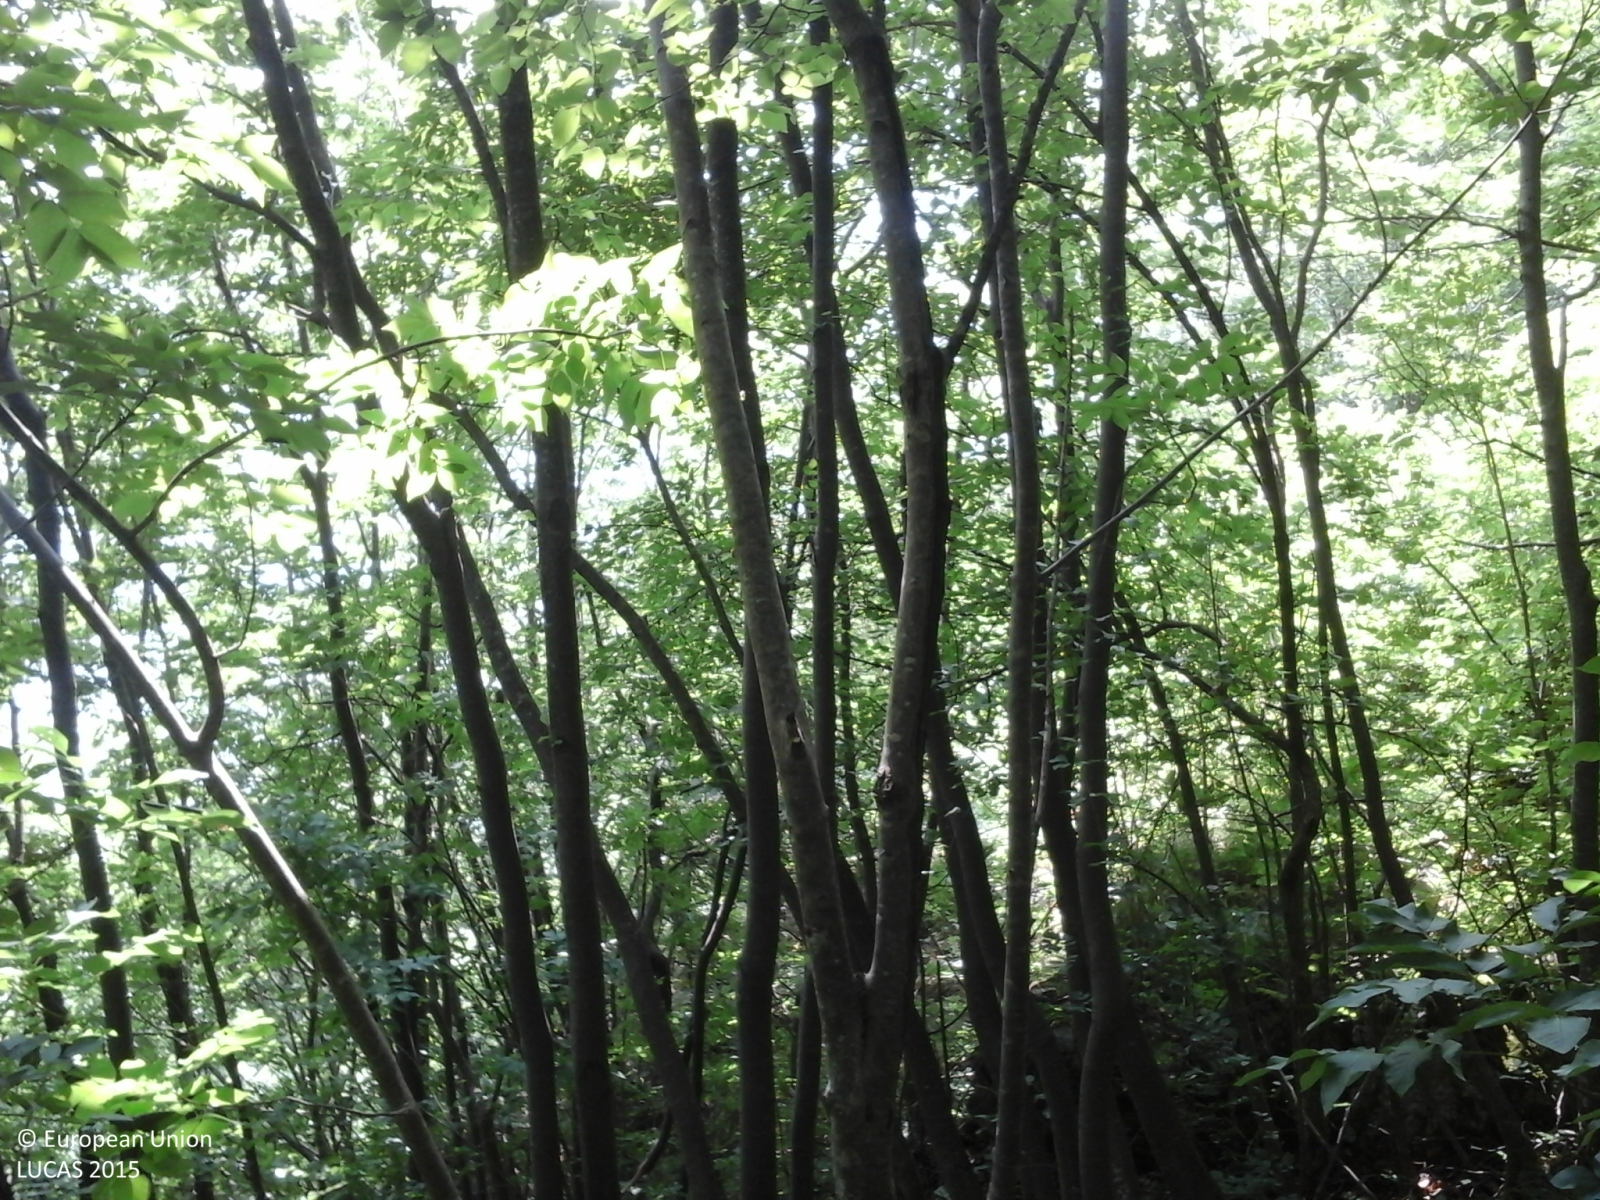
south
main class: Woodland
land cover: Broadleaved woodland
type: thermophilous deciduous forest
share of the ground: > 75 %
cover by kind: broadleaved forest trees 100 %
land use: Forestry
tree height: > 5 m
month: June
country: IT
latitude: 46.0033
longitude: 11.0960
